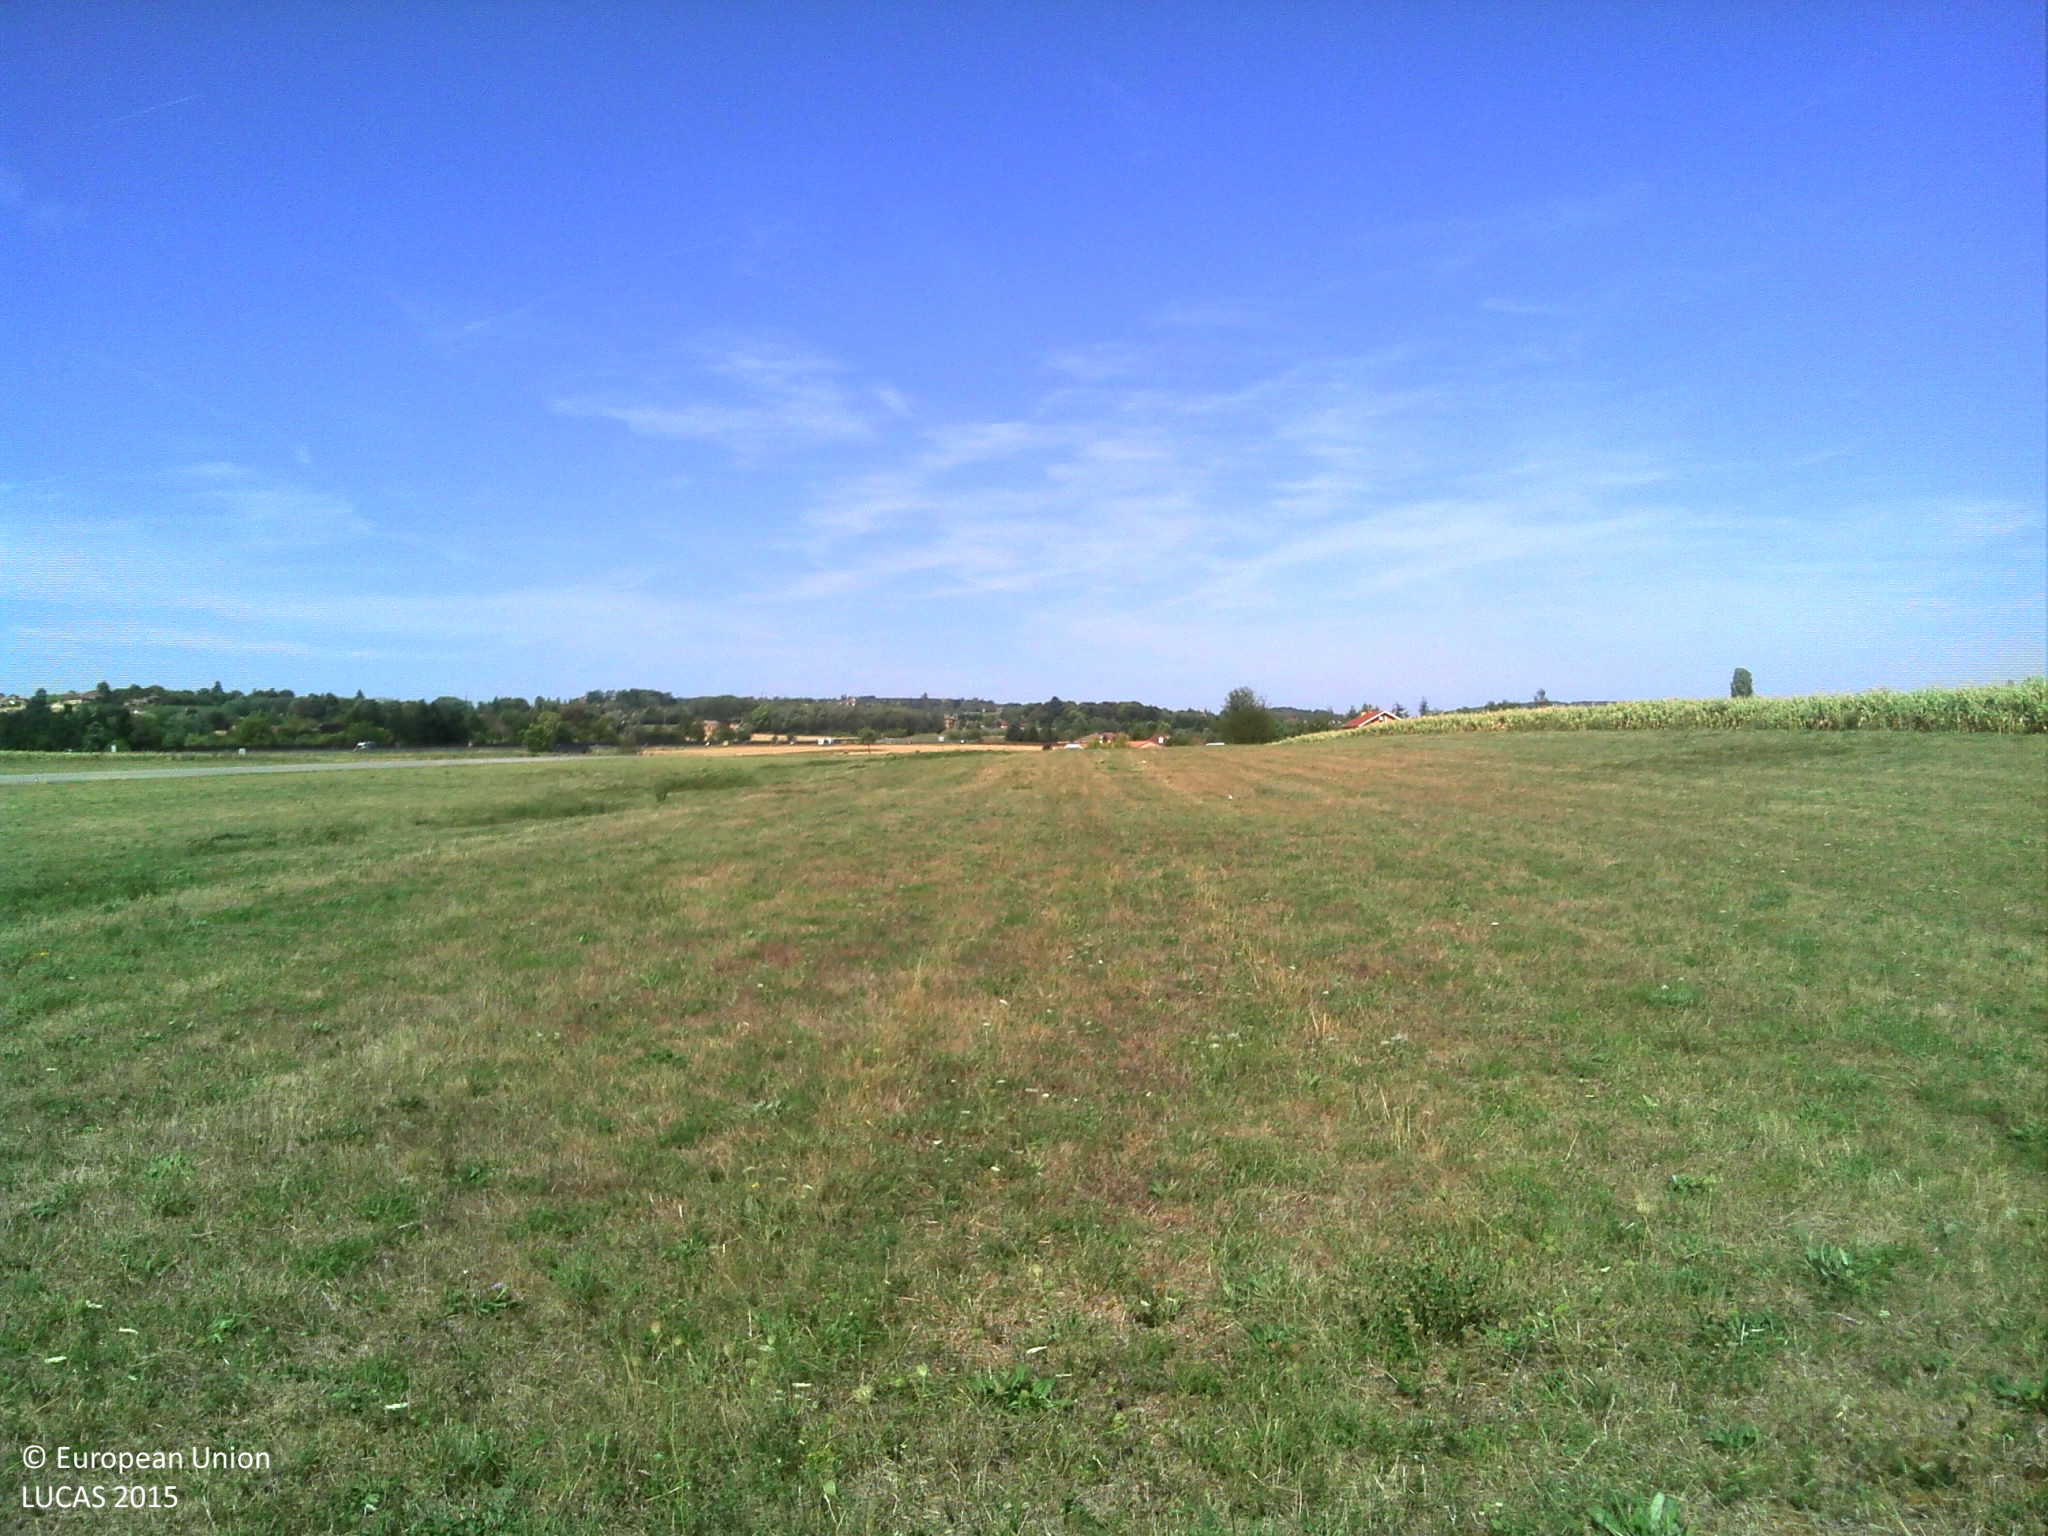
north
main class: Grassland
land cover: Grassland without tree/shrub cover
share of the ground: > 75 %
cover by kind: herbaceous plants 100 %
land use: Air transport
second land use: Agriculture (excluding fallow land and kitchen gardens)
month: August
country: FR
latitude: 46.2968
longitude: 4.7965
